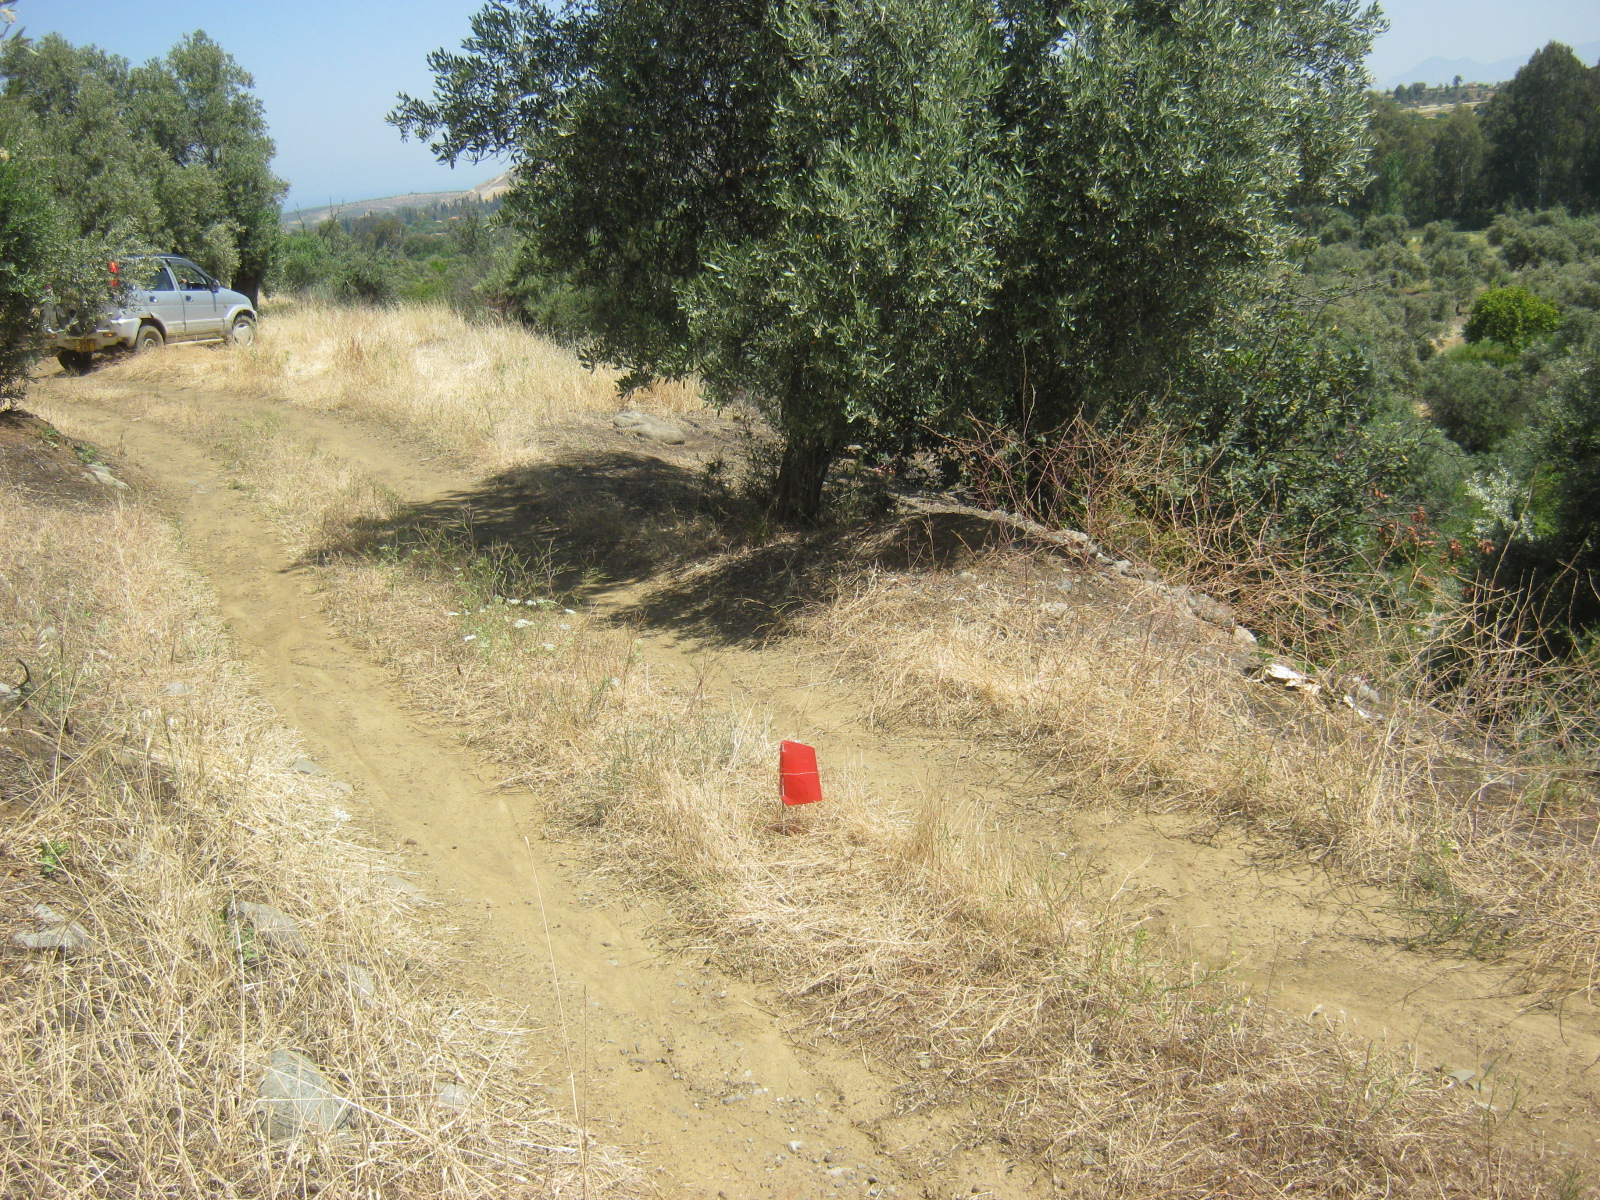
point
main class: Cropland
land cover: Olive groves
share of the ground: 50 - 75 %
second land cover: Grassland without tree/shrub cover
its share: > 75 %
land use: Agriculture (excluding fallow land and kitchen gardens)
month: May
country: CY
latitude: 35.0678
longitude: 32.8817
